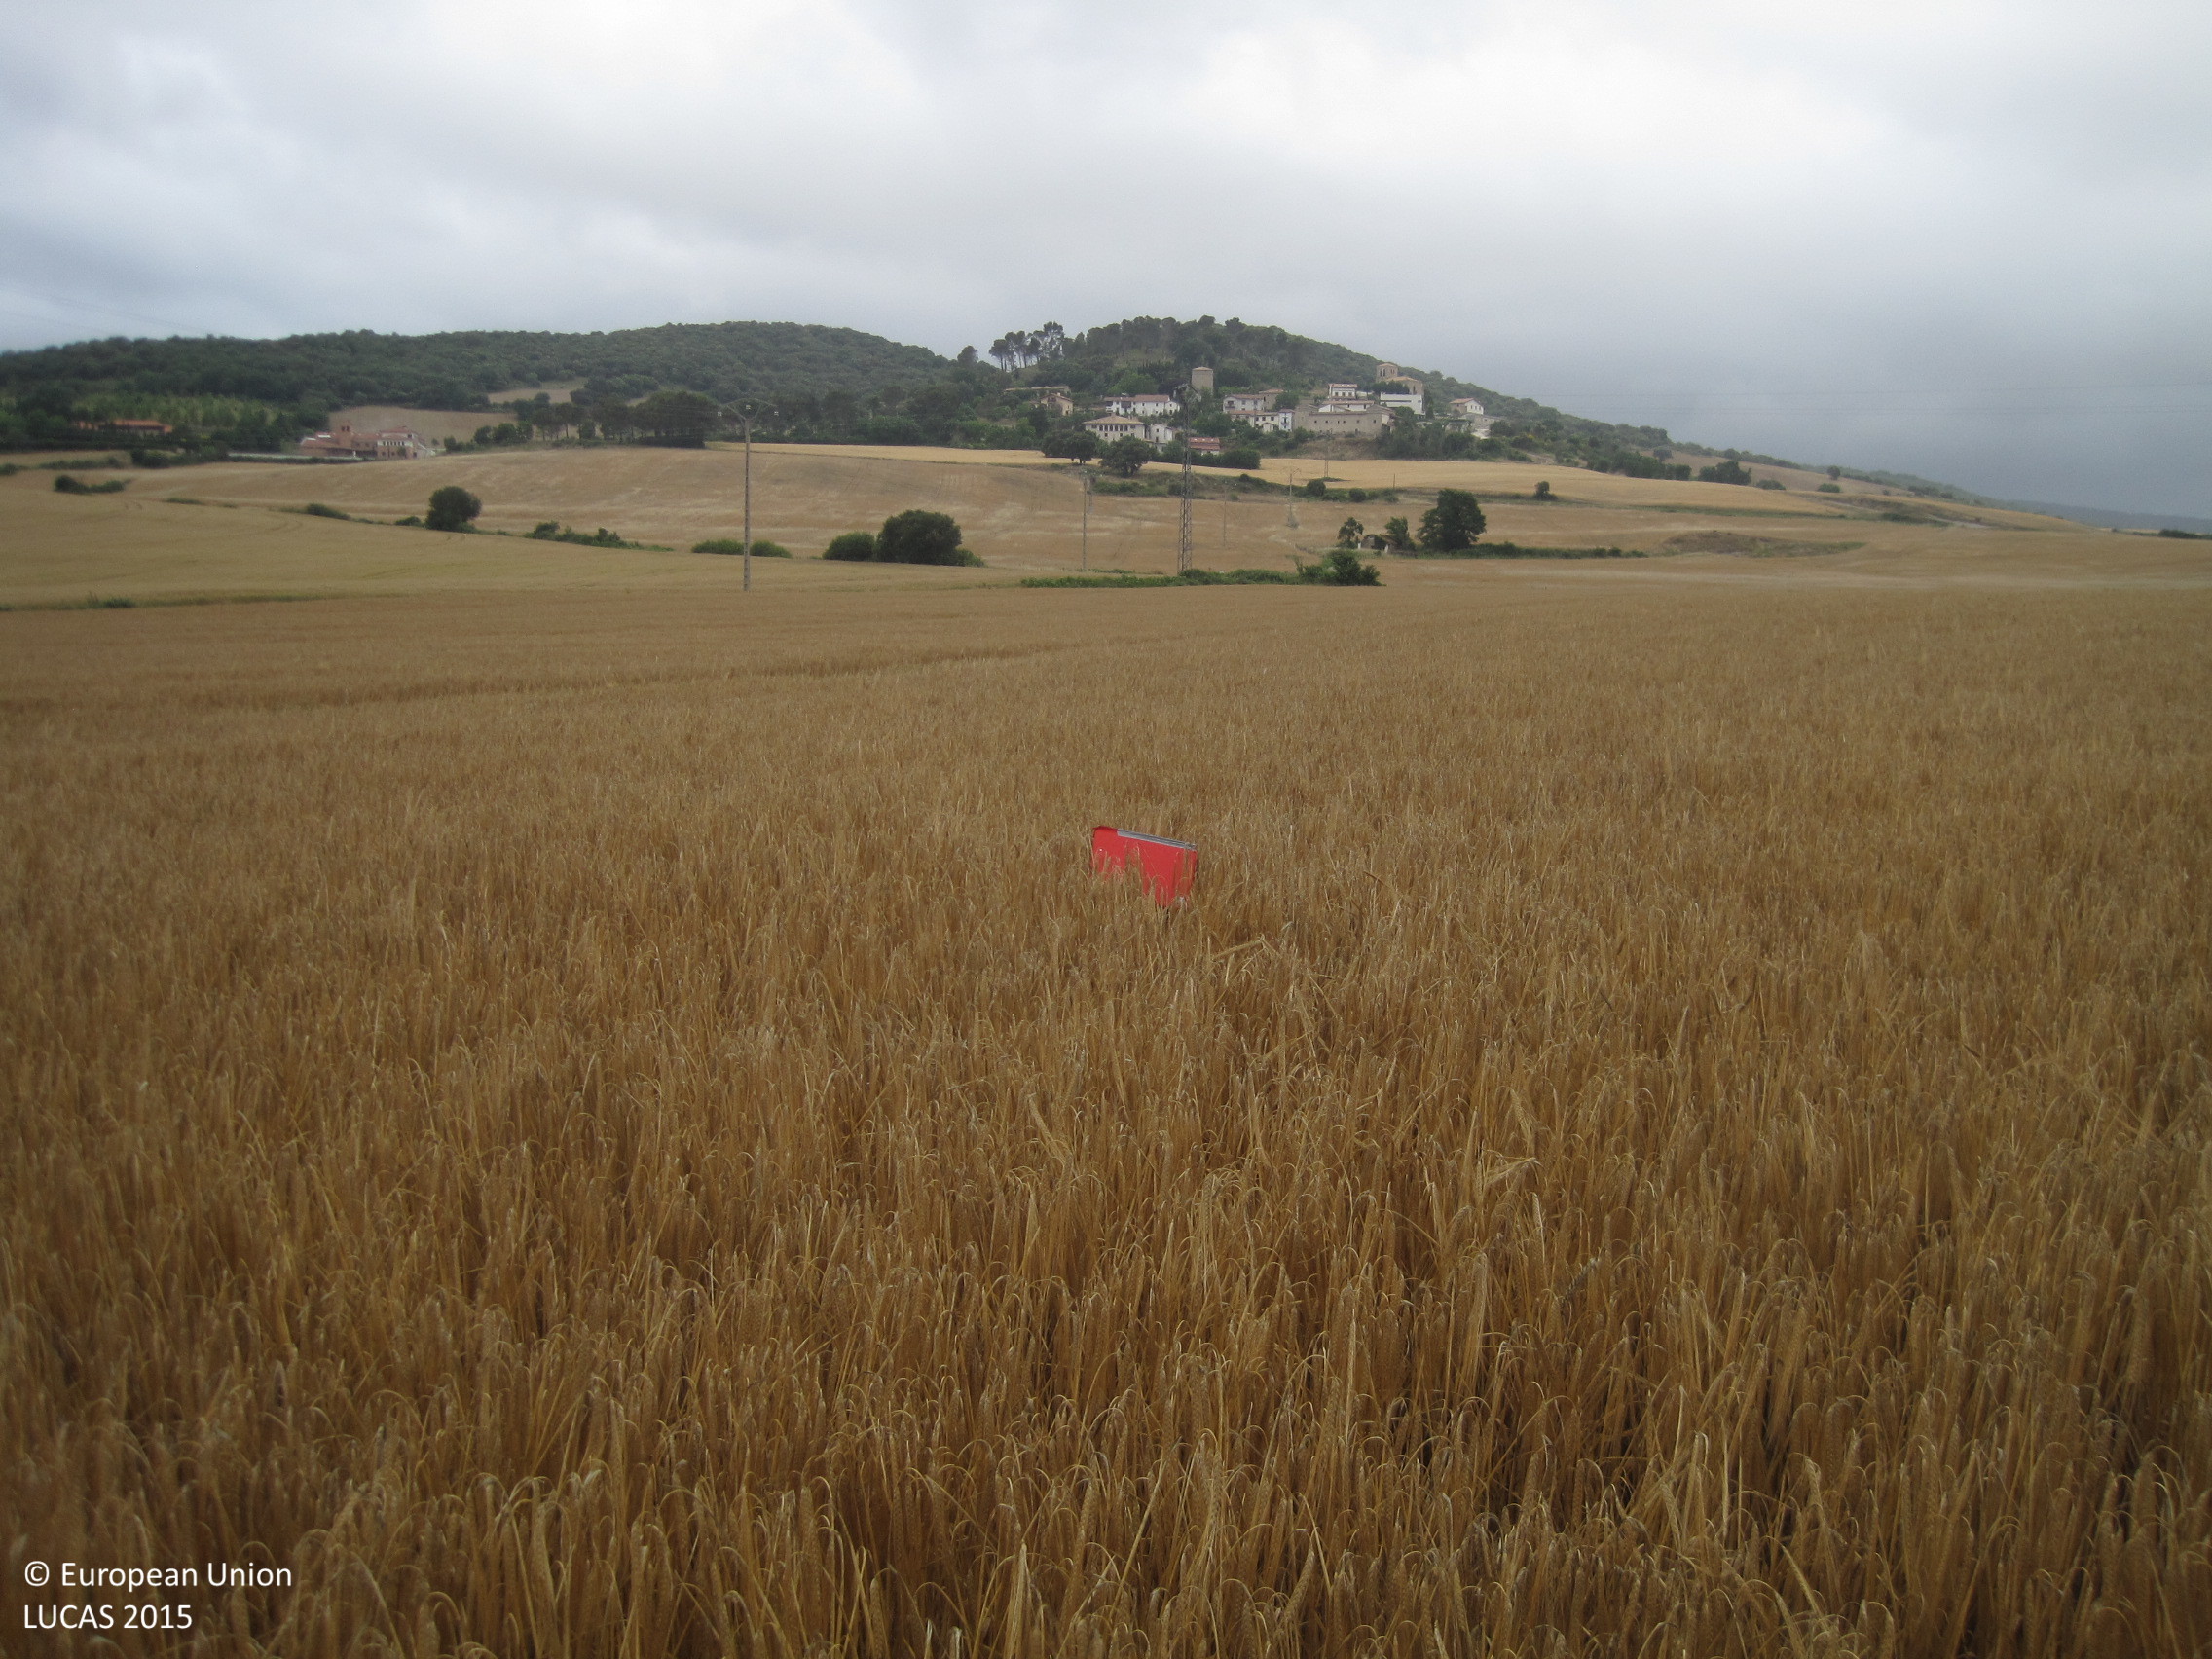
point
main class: Cropland
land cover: Barley
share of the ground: > 75 %
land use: Agriculture (excluding fallow land and kitchen gardens)
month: June
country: ES
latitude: 42.8397
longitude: -1.7740
